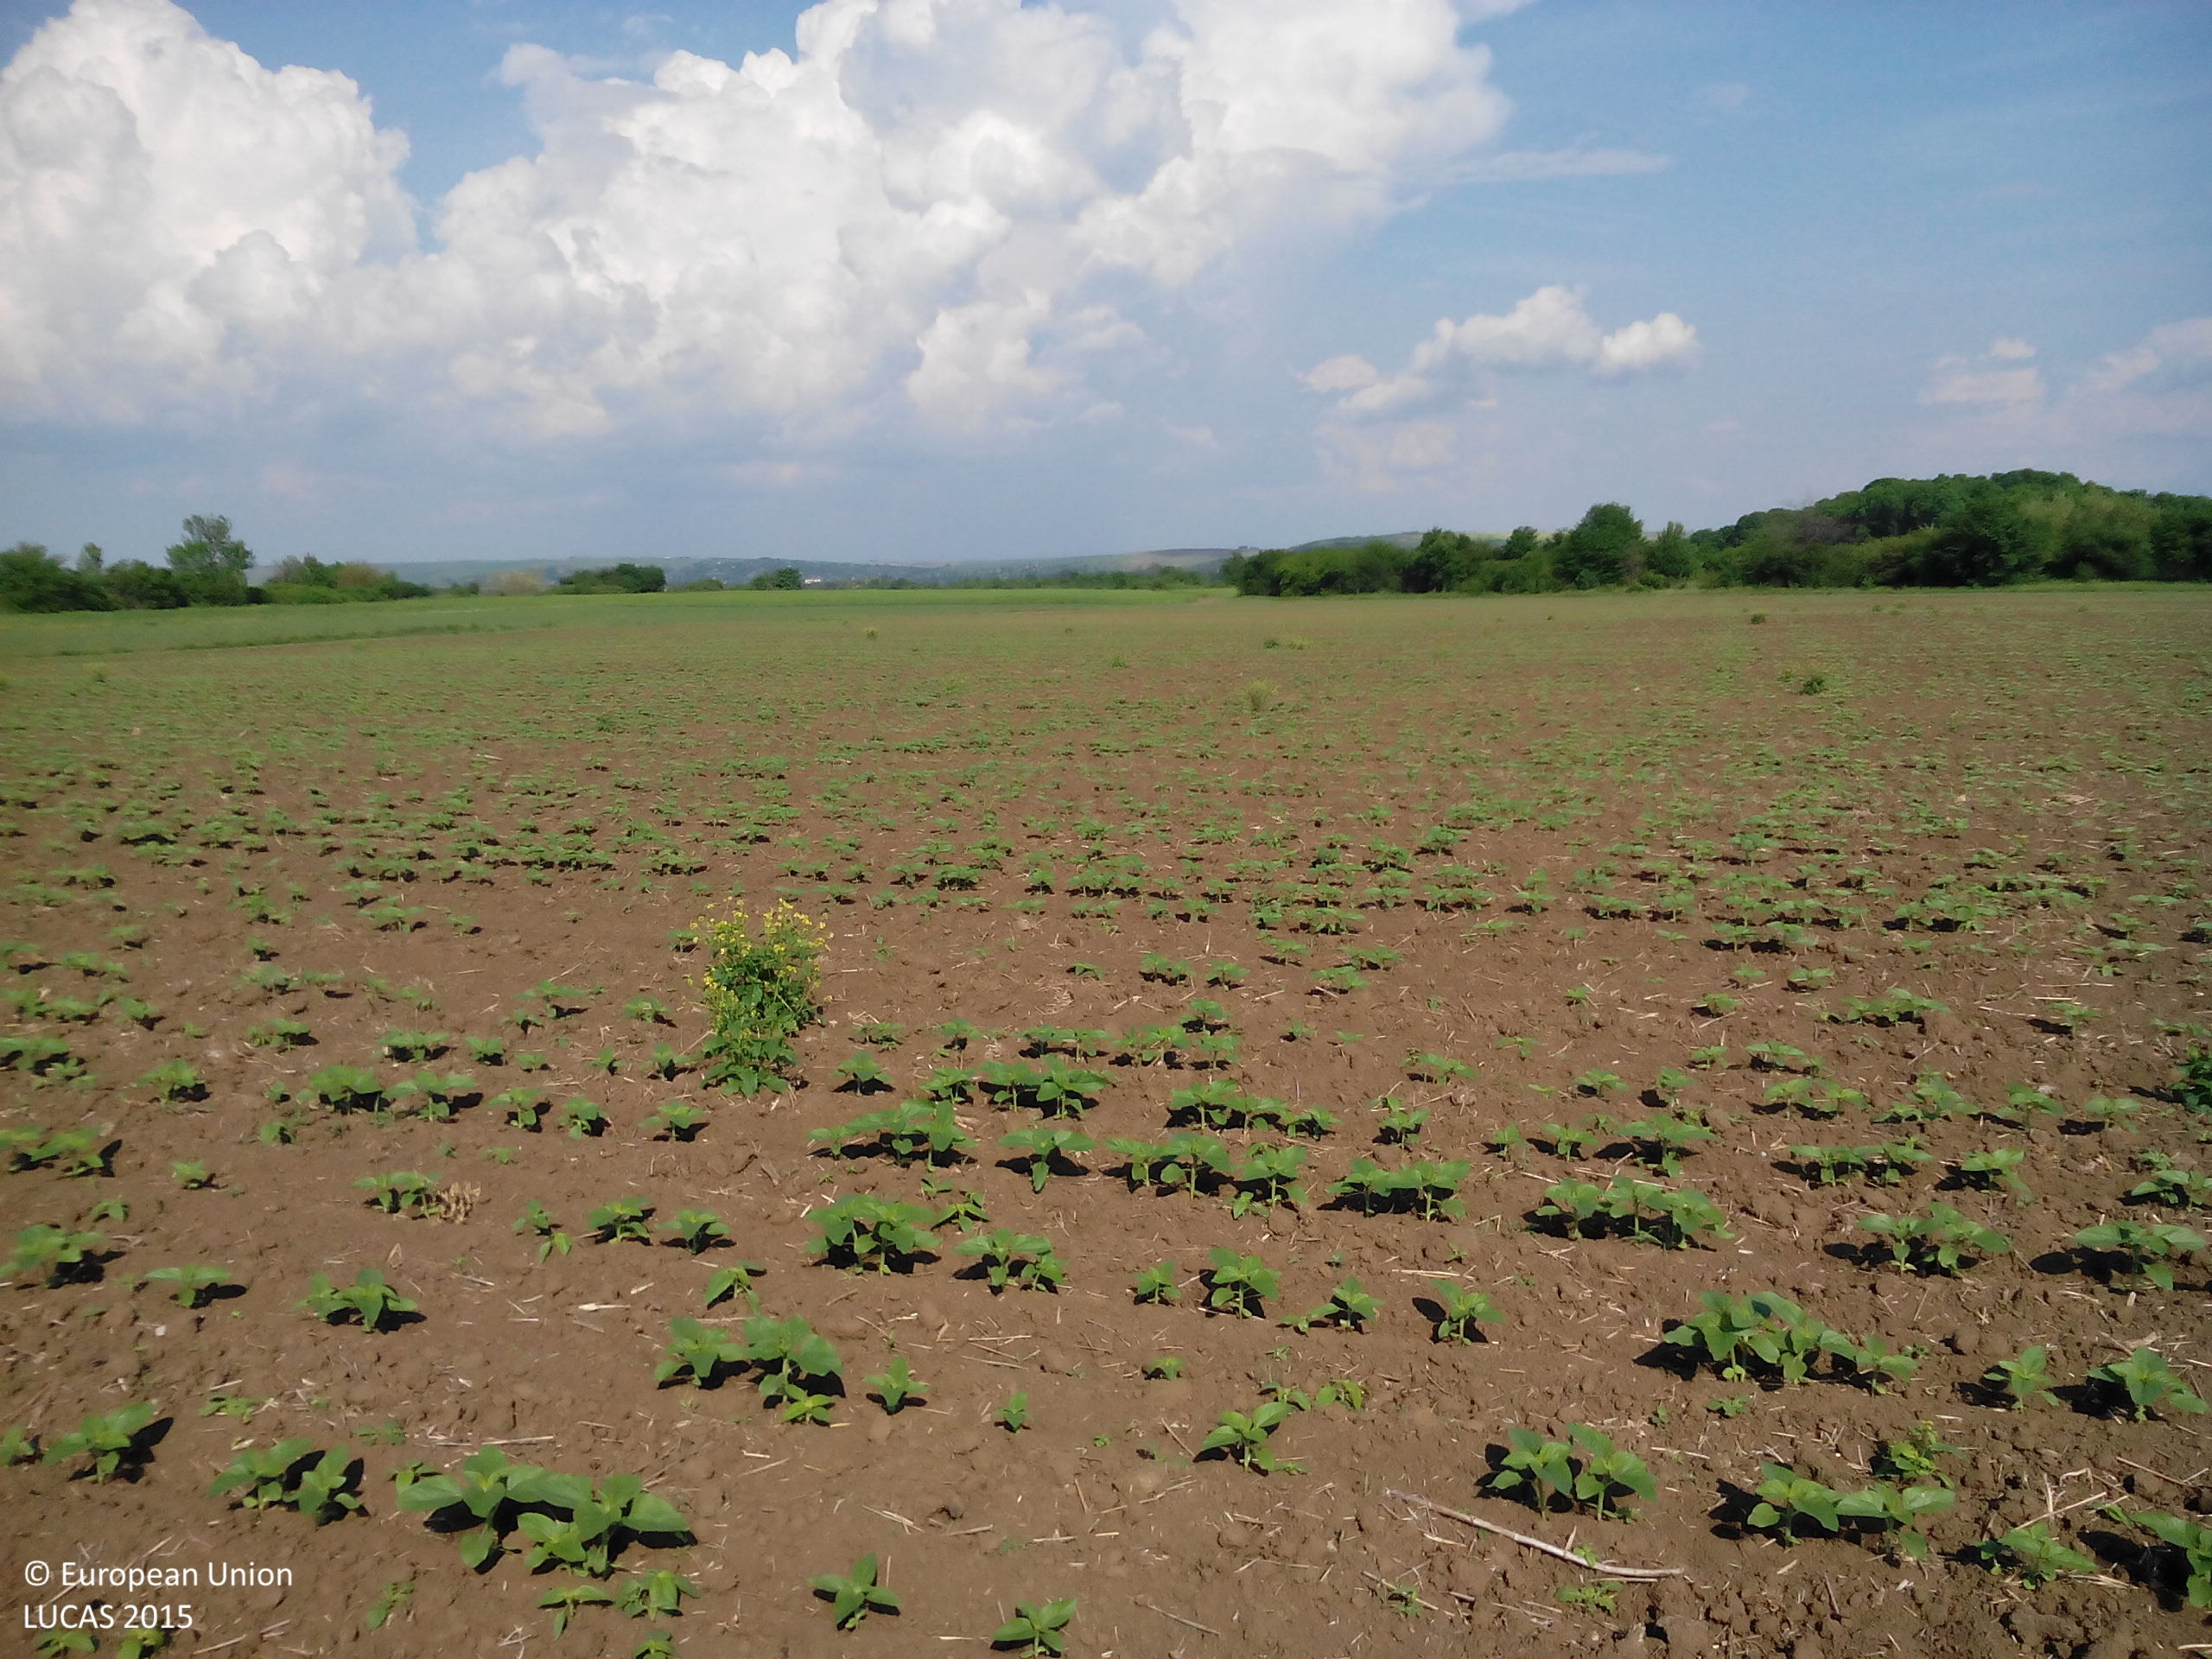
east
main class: Cropland
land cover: Sunflower
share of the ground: 10 - 25 %
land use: Agriculture (excluding fallow land and kitchen gardens)
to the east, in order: Sunflower; Grass margins; Tracks
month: May
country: BG
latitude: 43.5511
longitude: 23.8018
